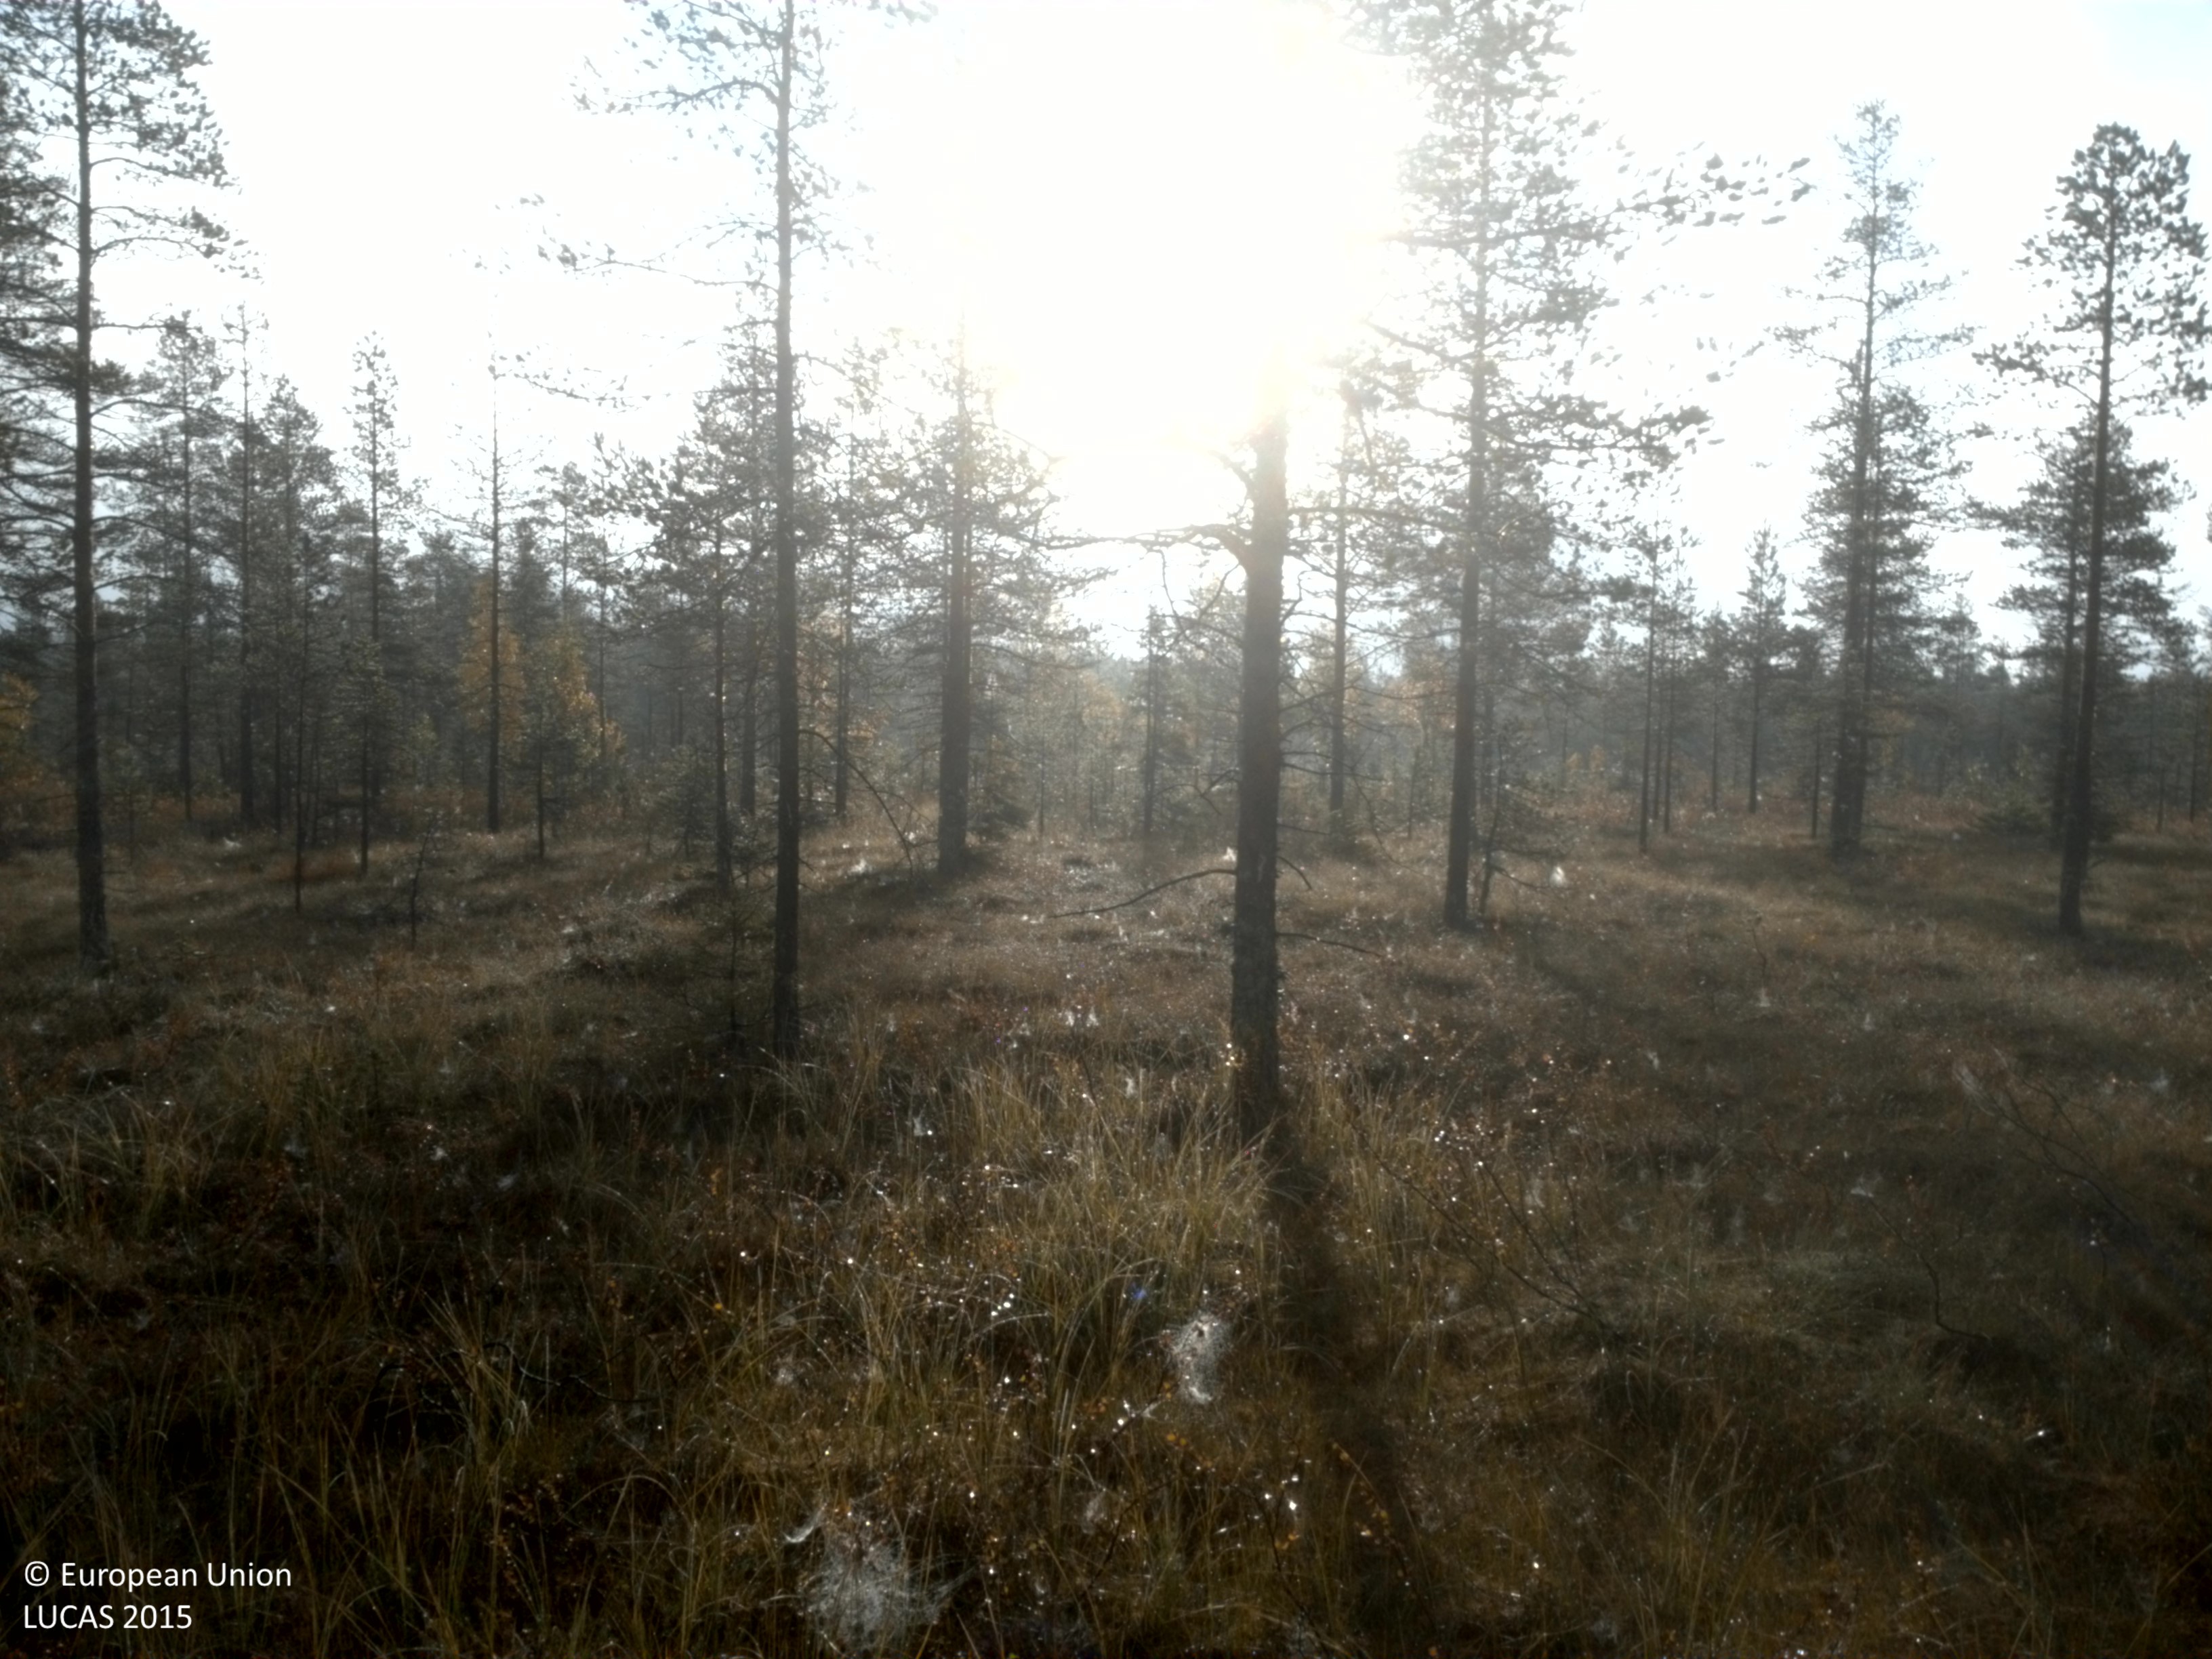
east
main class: Woodland
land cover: Pine dominated coniferous woodland
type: boreal forest
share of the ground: 25 - 50 %
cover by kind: lichens and mosses 40 %, coniferous forest trees 25 %, shrubs 20 %, herbaceous plants 10 %, broadleaved forest trees 5 %
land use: Amenities, museums, leisure
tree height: > 5 m
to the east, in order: Pine dominated coniferous woodland; Pine dominated mixed woodland; Ditches and canals; Other coniferous woodland; Shrubland with sparse tree cover; Pine dominated coniferous woodland; Pine dominated mixed woodland
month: September
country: SE
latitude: 64.3768
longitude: 20.2356
